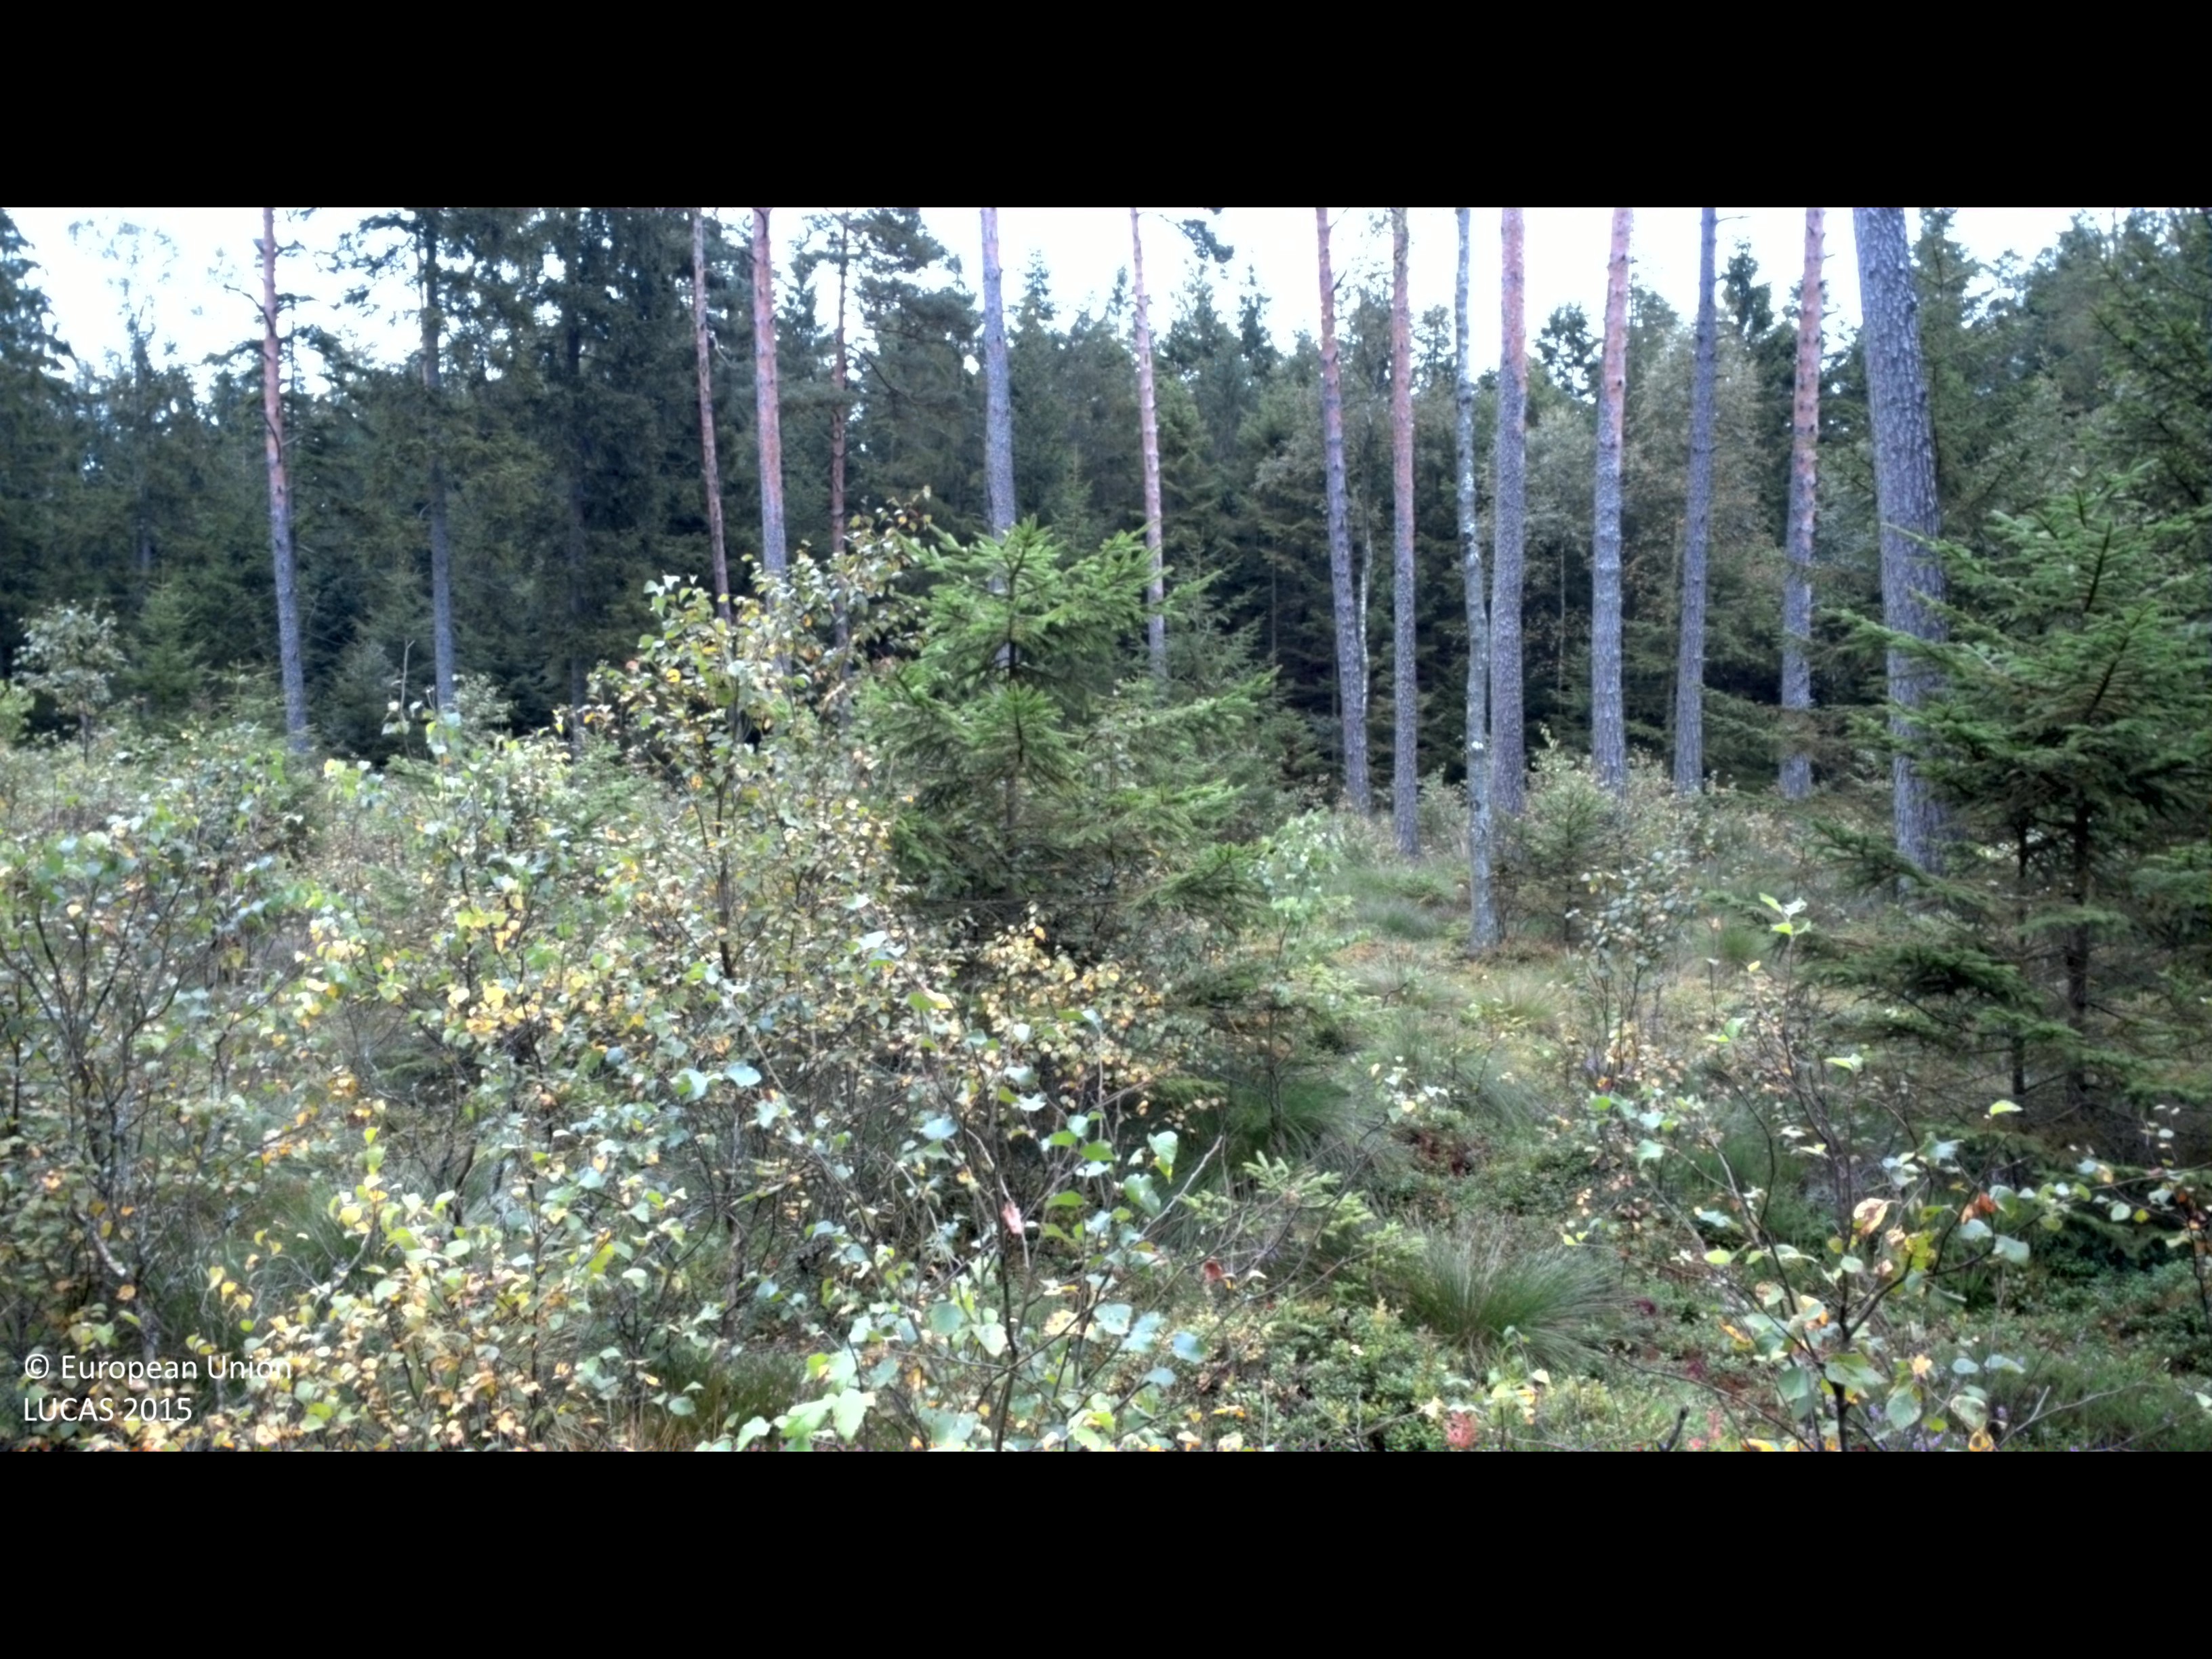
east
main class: Woodland
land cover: Spruce dominated mixed woodland
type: boreal forest
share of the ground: 50 - 75 %
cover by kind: coniferous forest trees 35 %, broadleaved forest trees 35 %, shrubs 15 %, herbaceous plants 15 %
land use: Forestry
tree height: < 5 m
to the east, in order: Spruce dominated mixed woodland; Pine dominated mixed woodland; Spruce dominated coniferous woodland; Spruce dominated mixed woodland; Spruce dominated coniferous woodland; Tracks; Spruce dominated mixed woodland
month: September
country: SE
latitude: 56.8229
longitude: 12.7986
